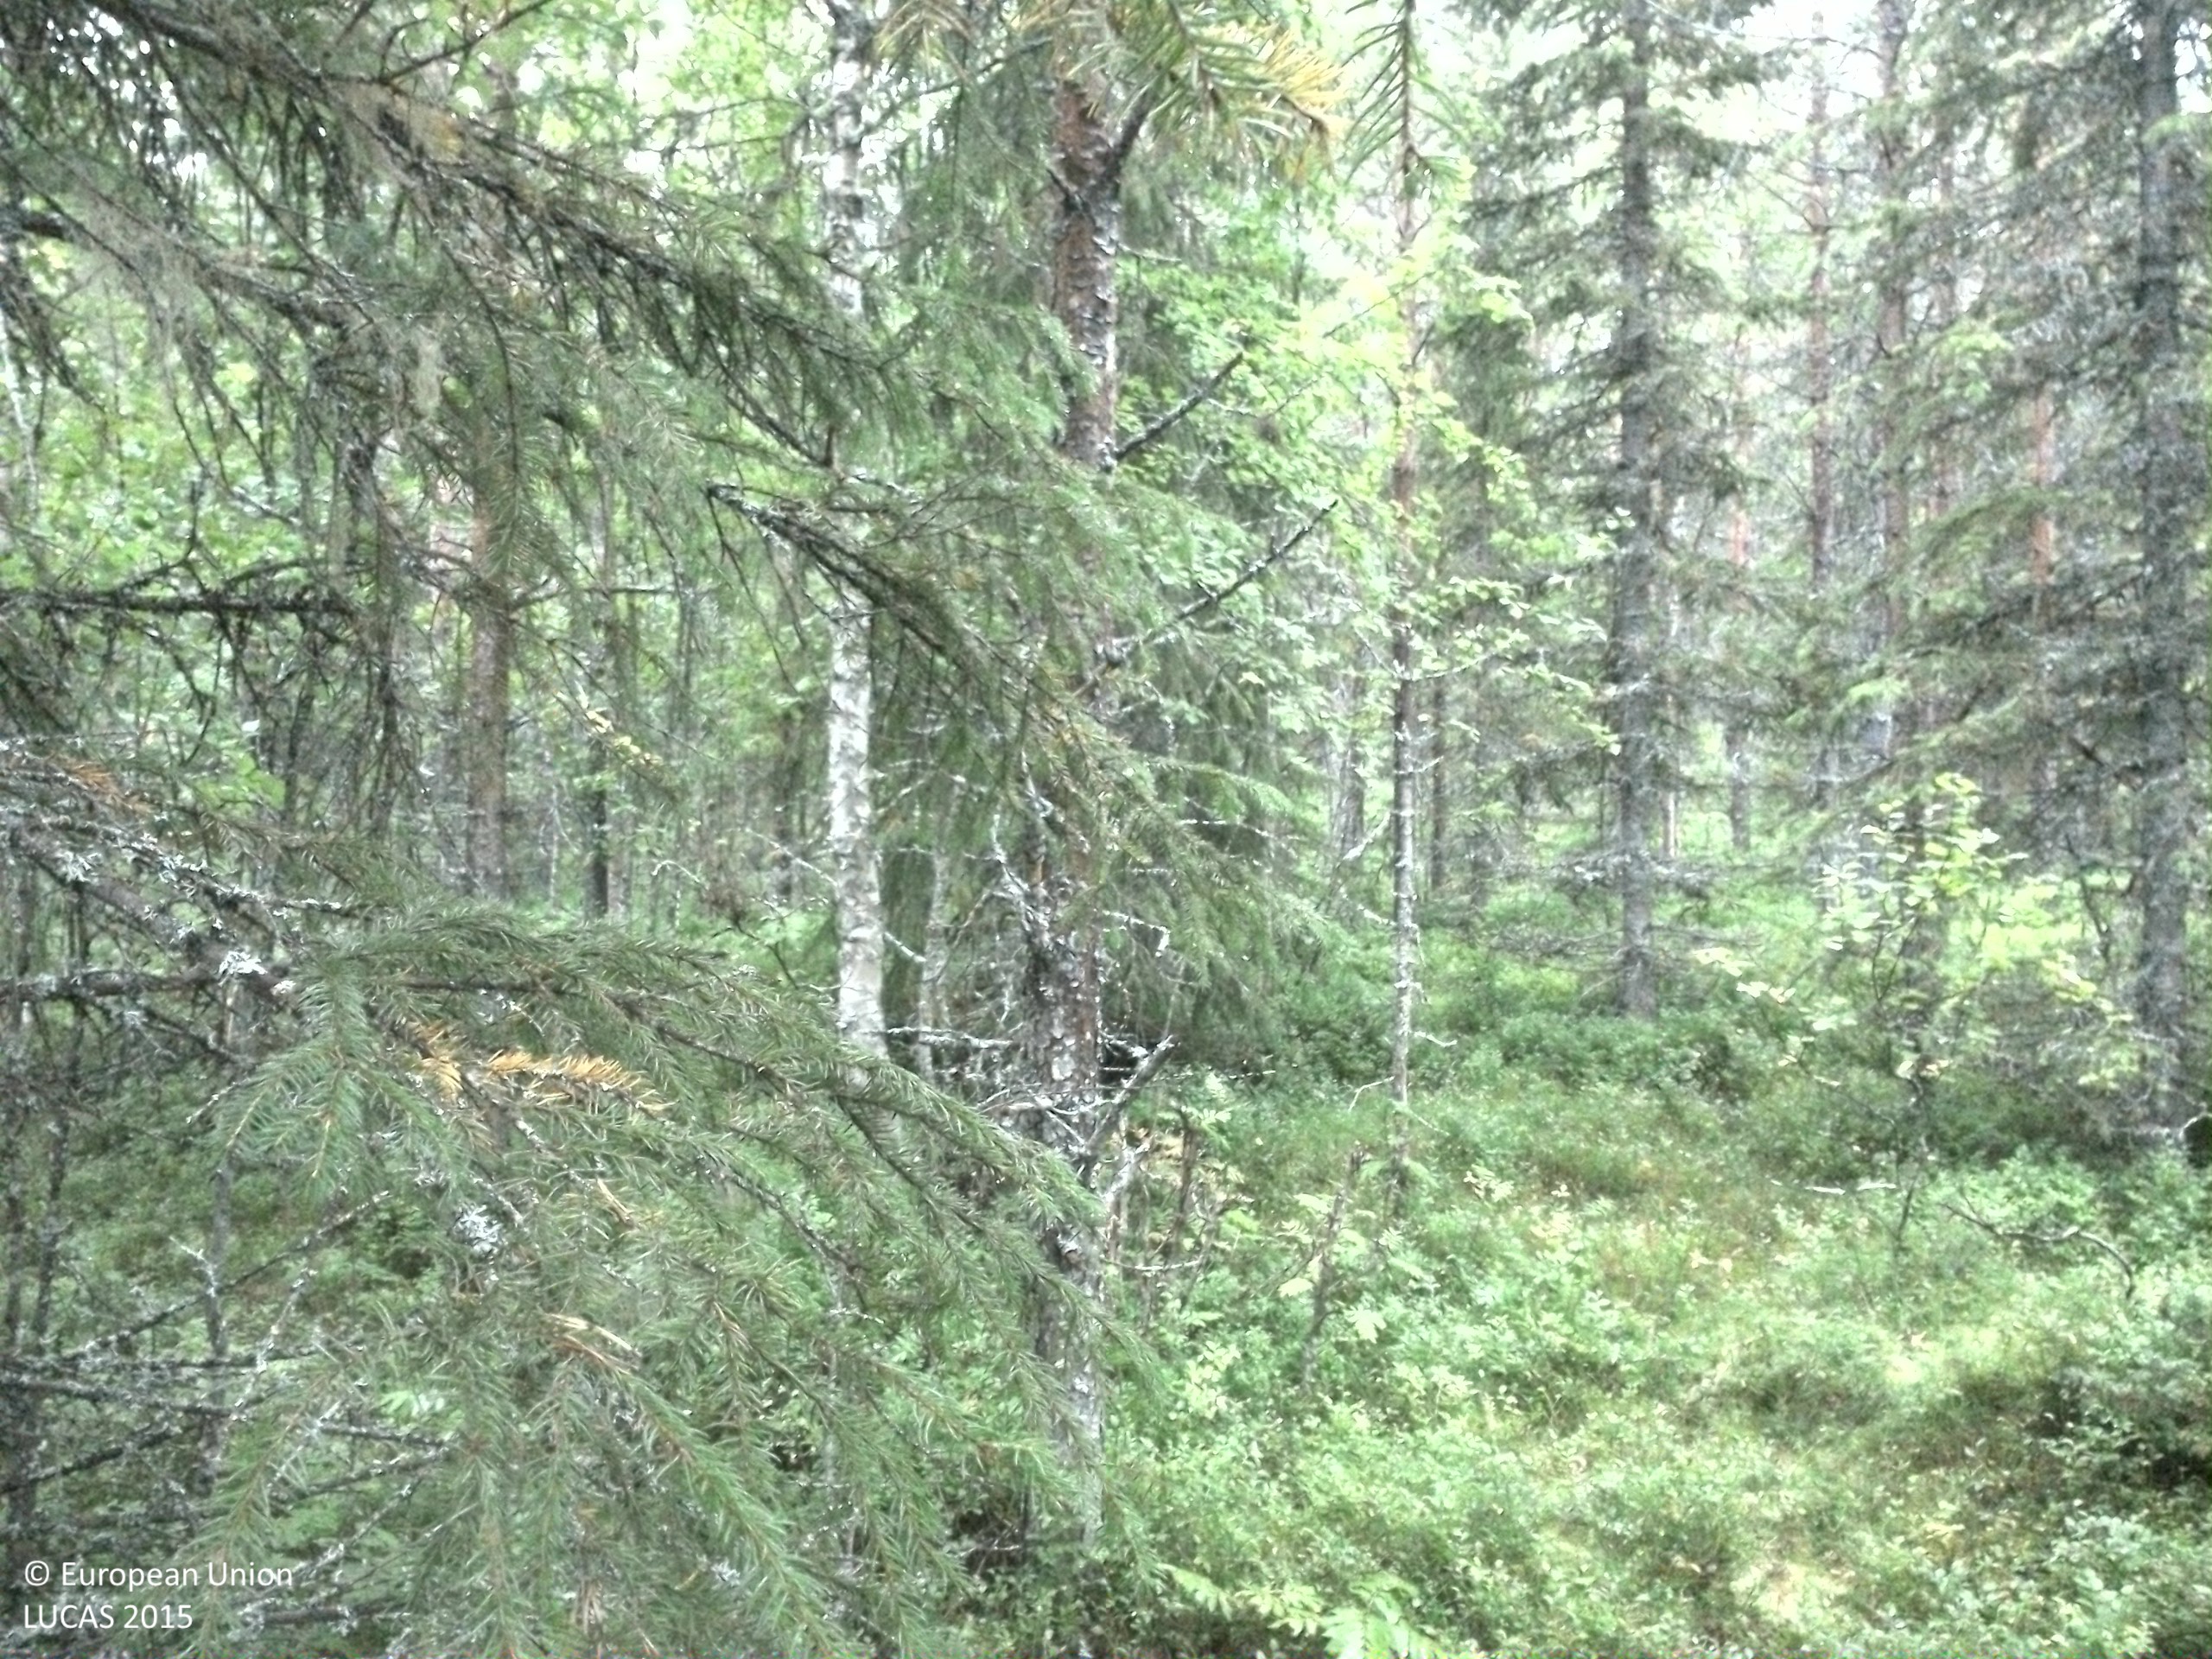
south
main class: Woodland
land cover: Spruce dominated coniferous woodland
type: boreal forest
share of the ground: > 75 %
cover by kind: coniferous forest trees 75 %, shrubs 15 %, broadleaved forest trees 10 %
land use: Forestry
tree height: > 5 m
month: August
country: SE
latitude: 63.8467
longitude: 17.3530
